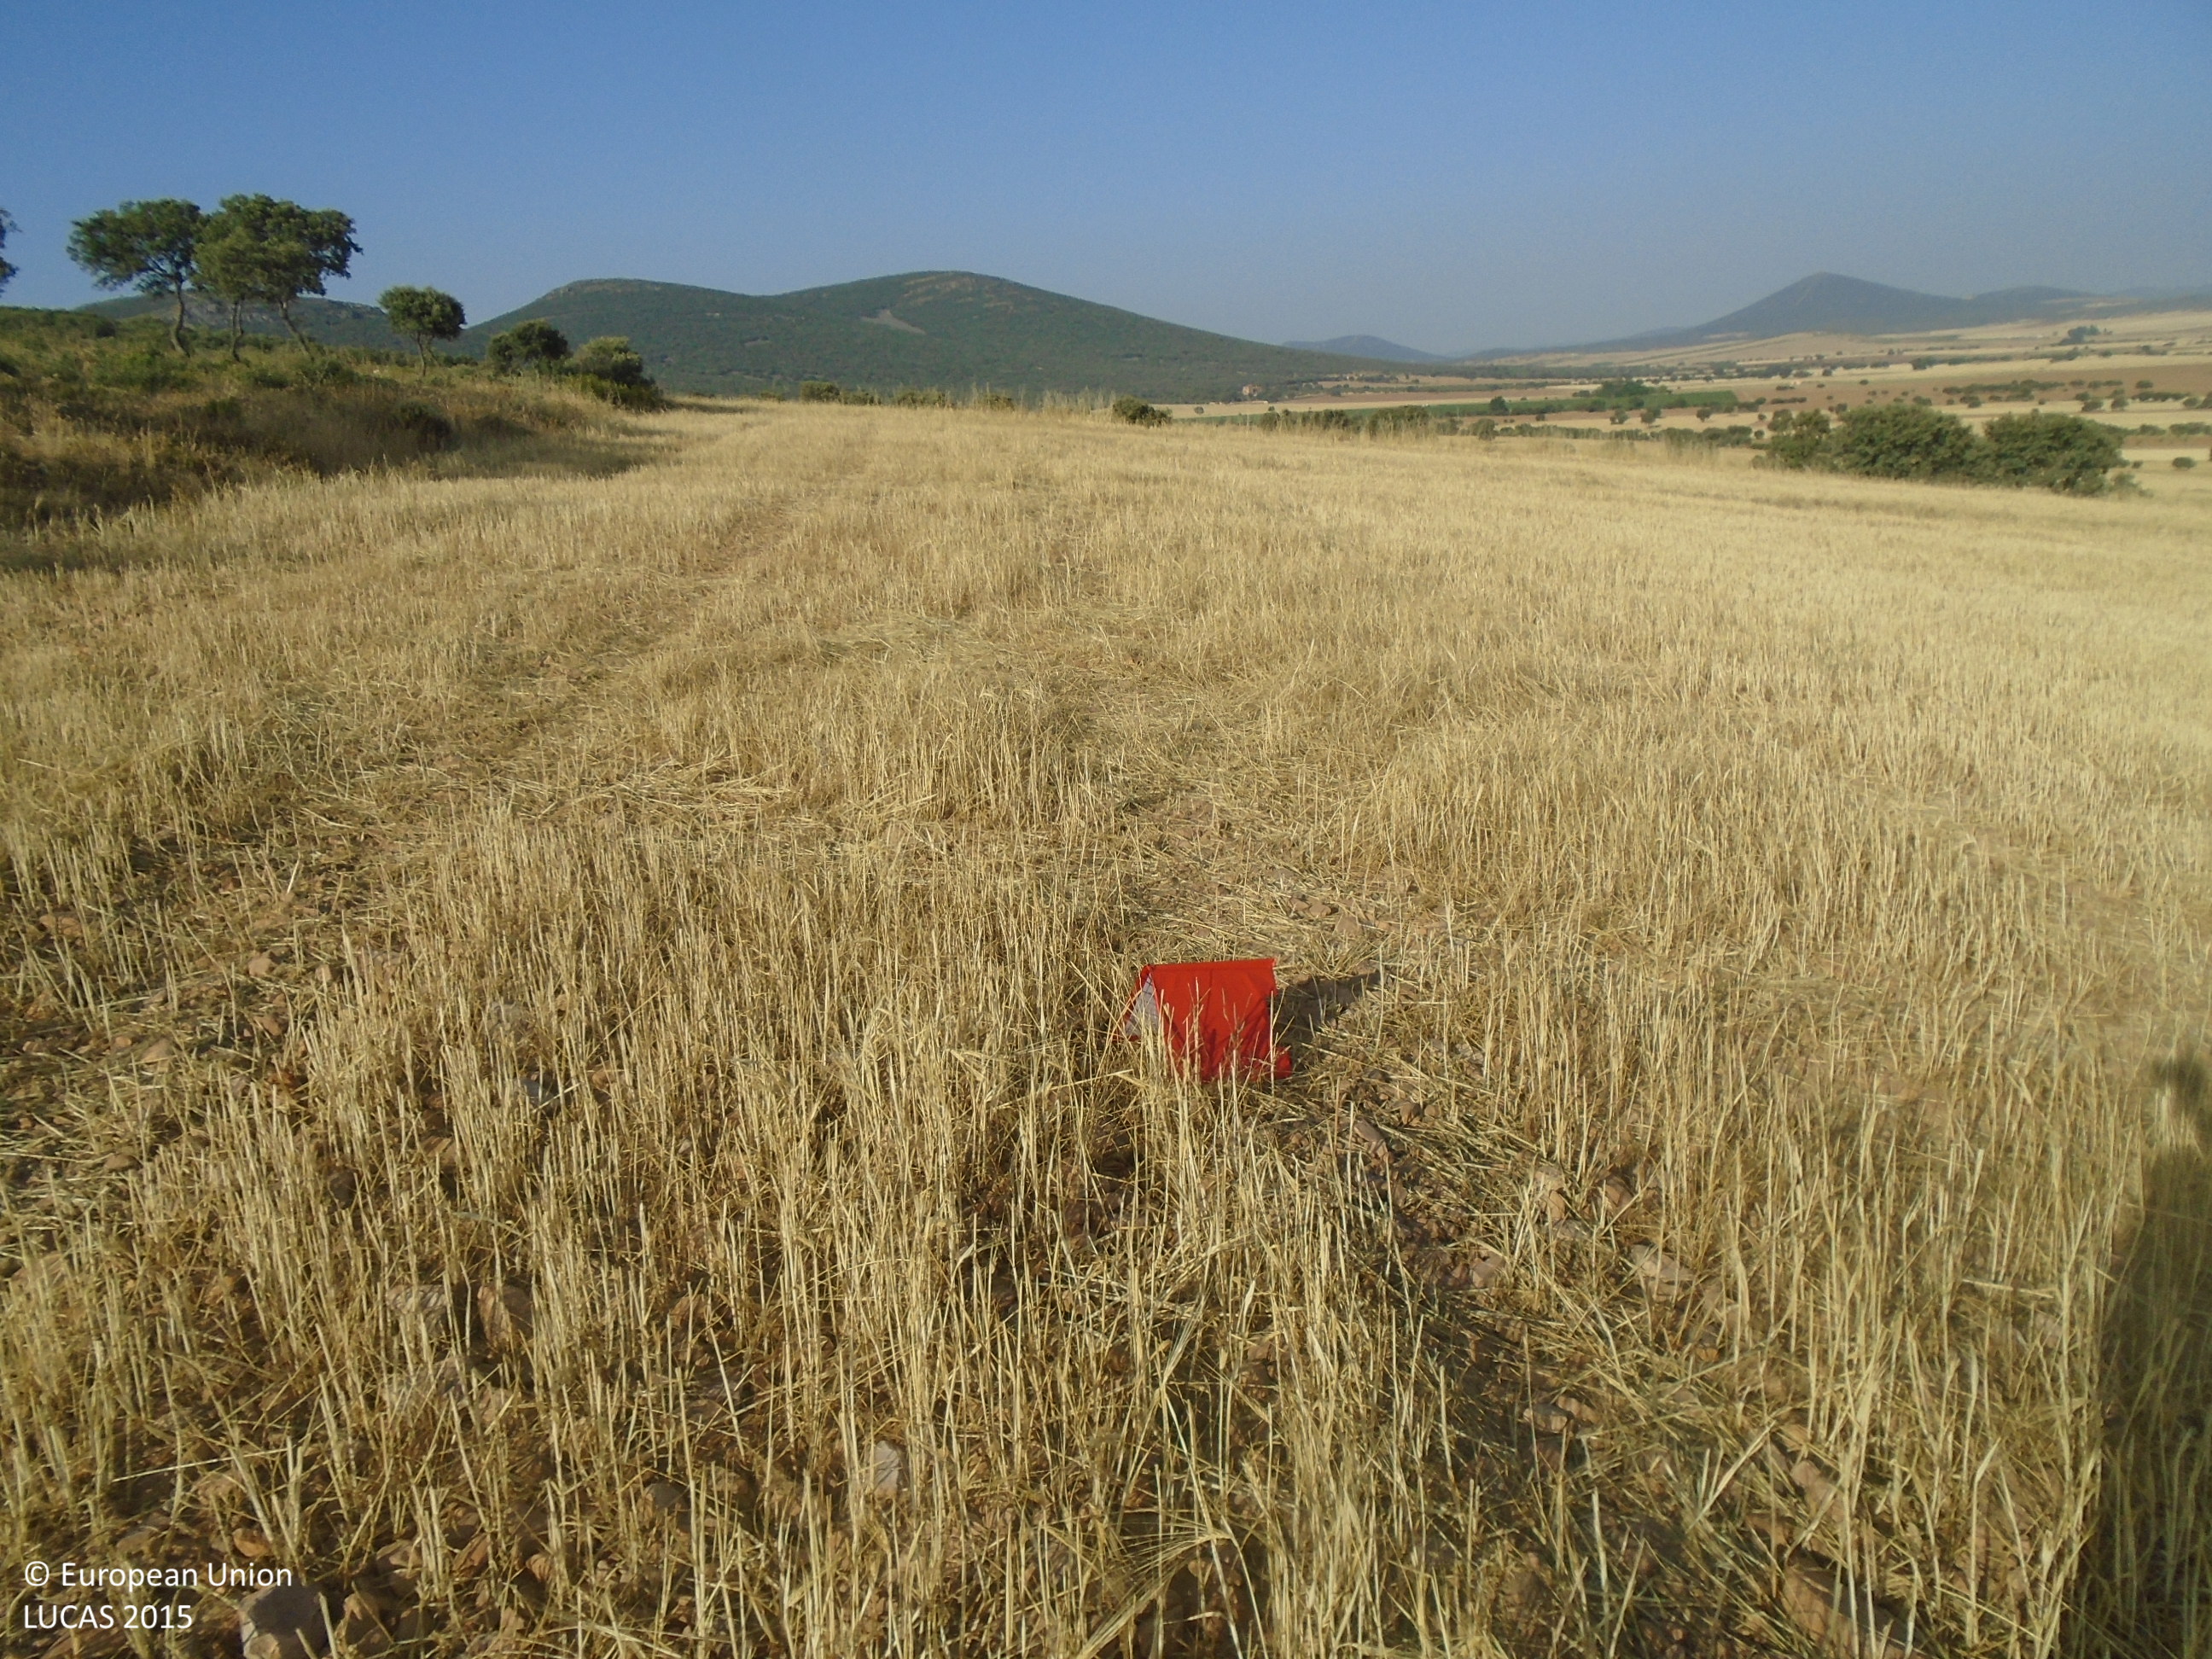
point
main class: Cropland
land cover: Barley
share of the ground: > 75 %
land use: Agriculture (excluding fallow land and kitchen gardens)
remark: Harvested field
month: July
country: ES
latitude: 39.3587
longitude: -3.6826
